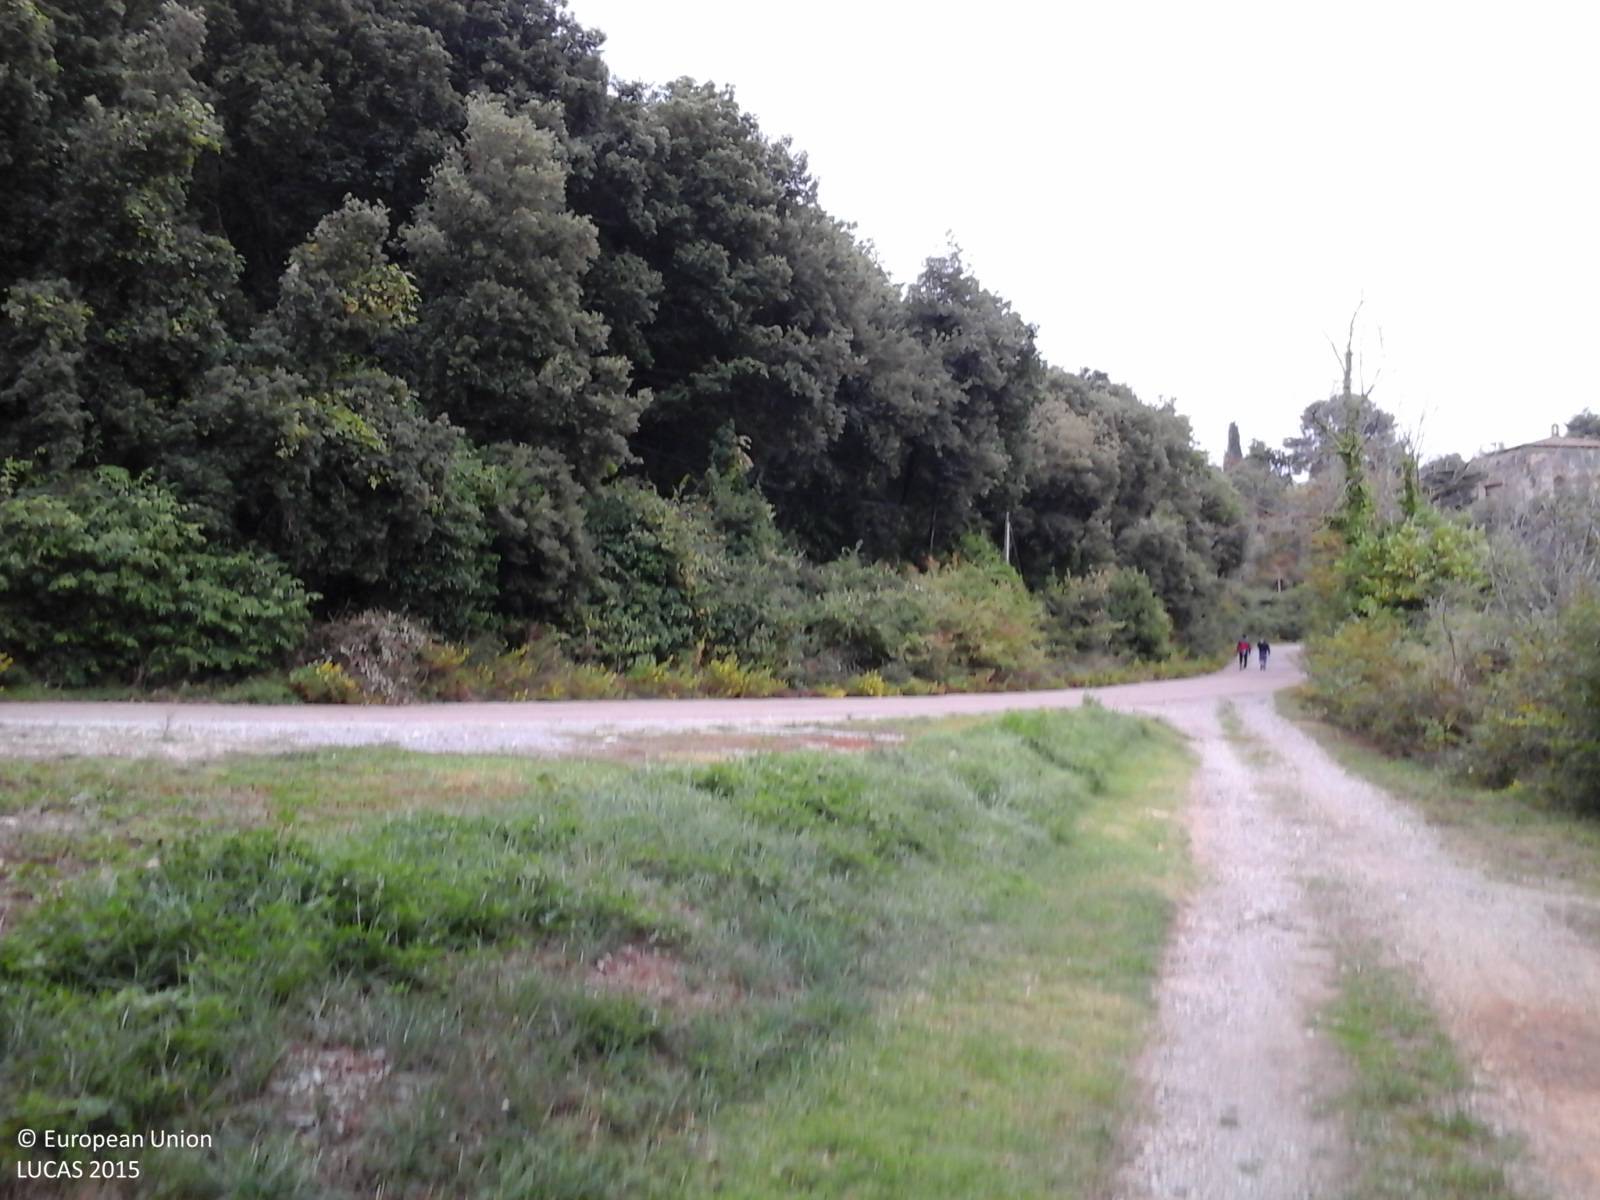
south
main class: Grassland
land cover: Grassland without tree/shrub cover
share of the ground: 25 - 50 %
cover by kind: herbaceous plants 100 %
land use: Residential
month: October
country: IT
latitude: 43.5380
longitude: 10.3826
